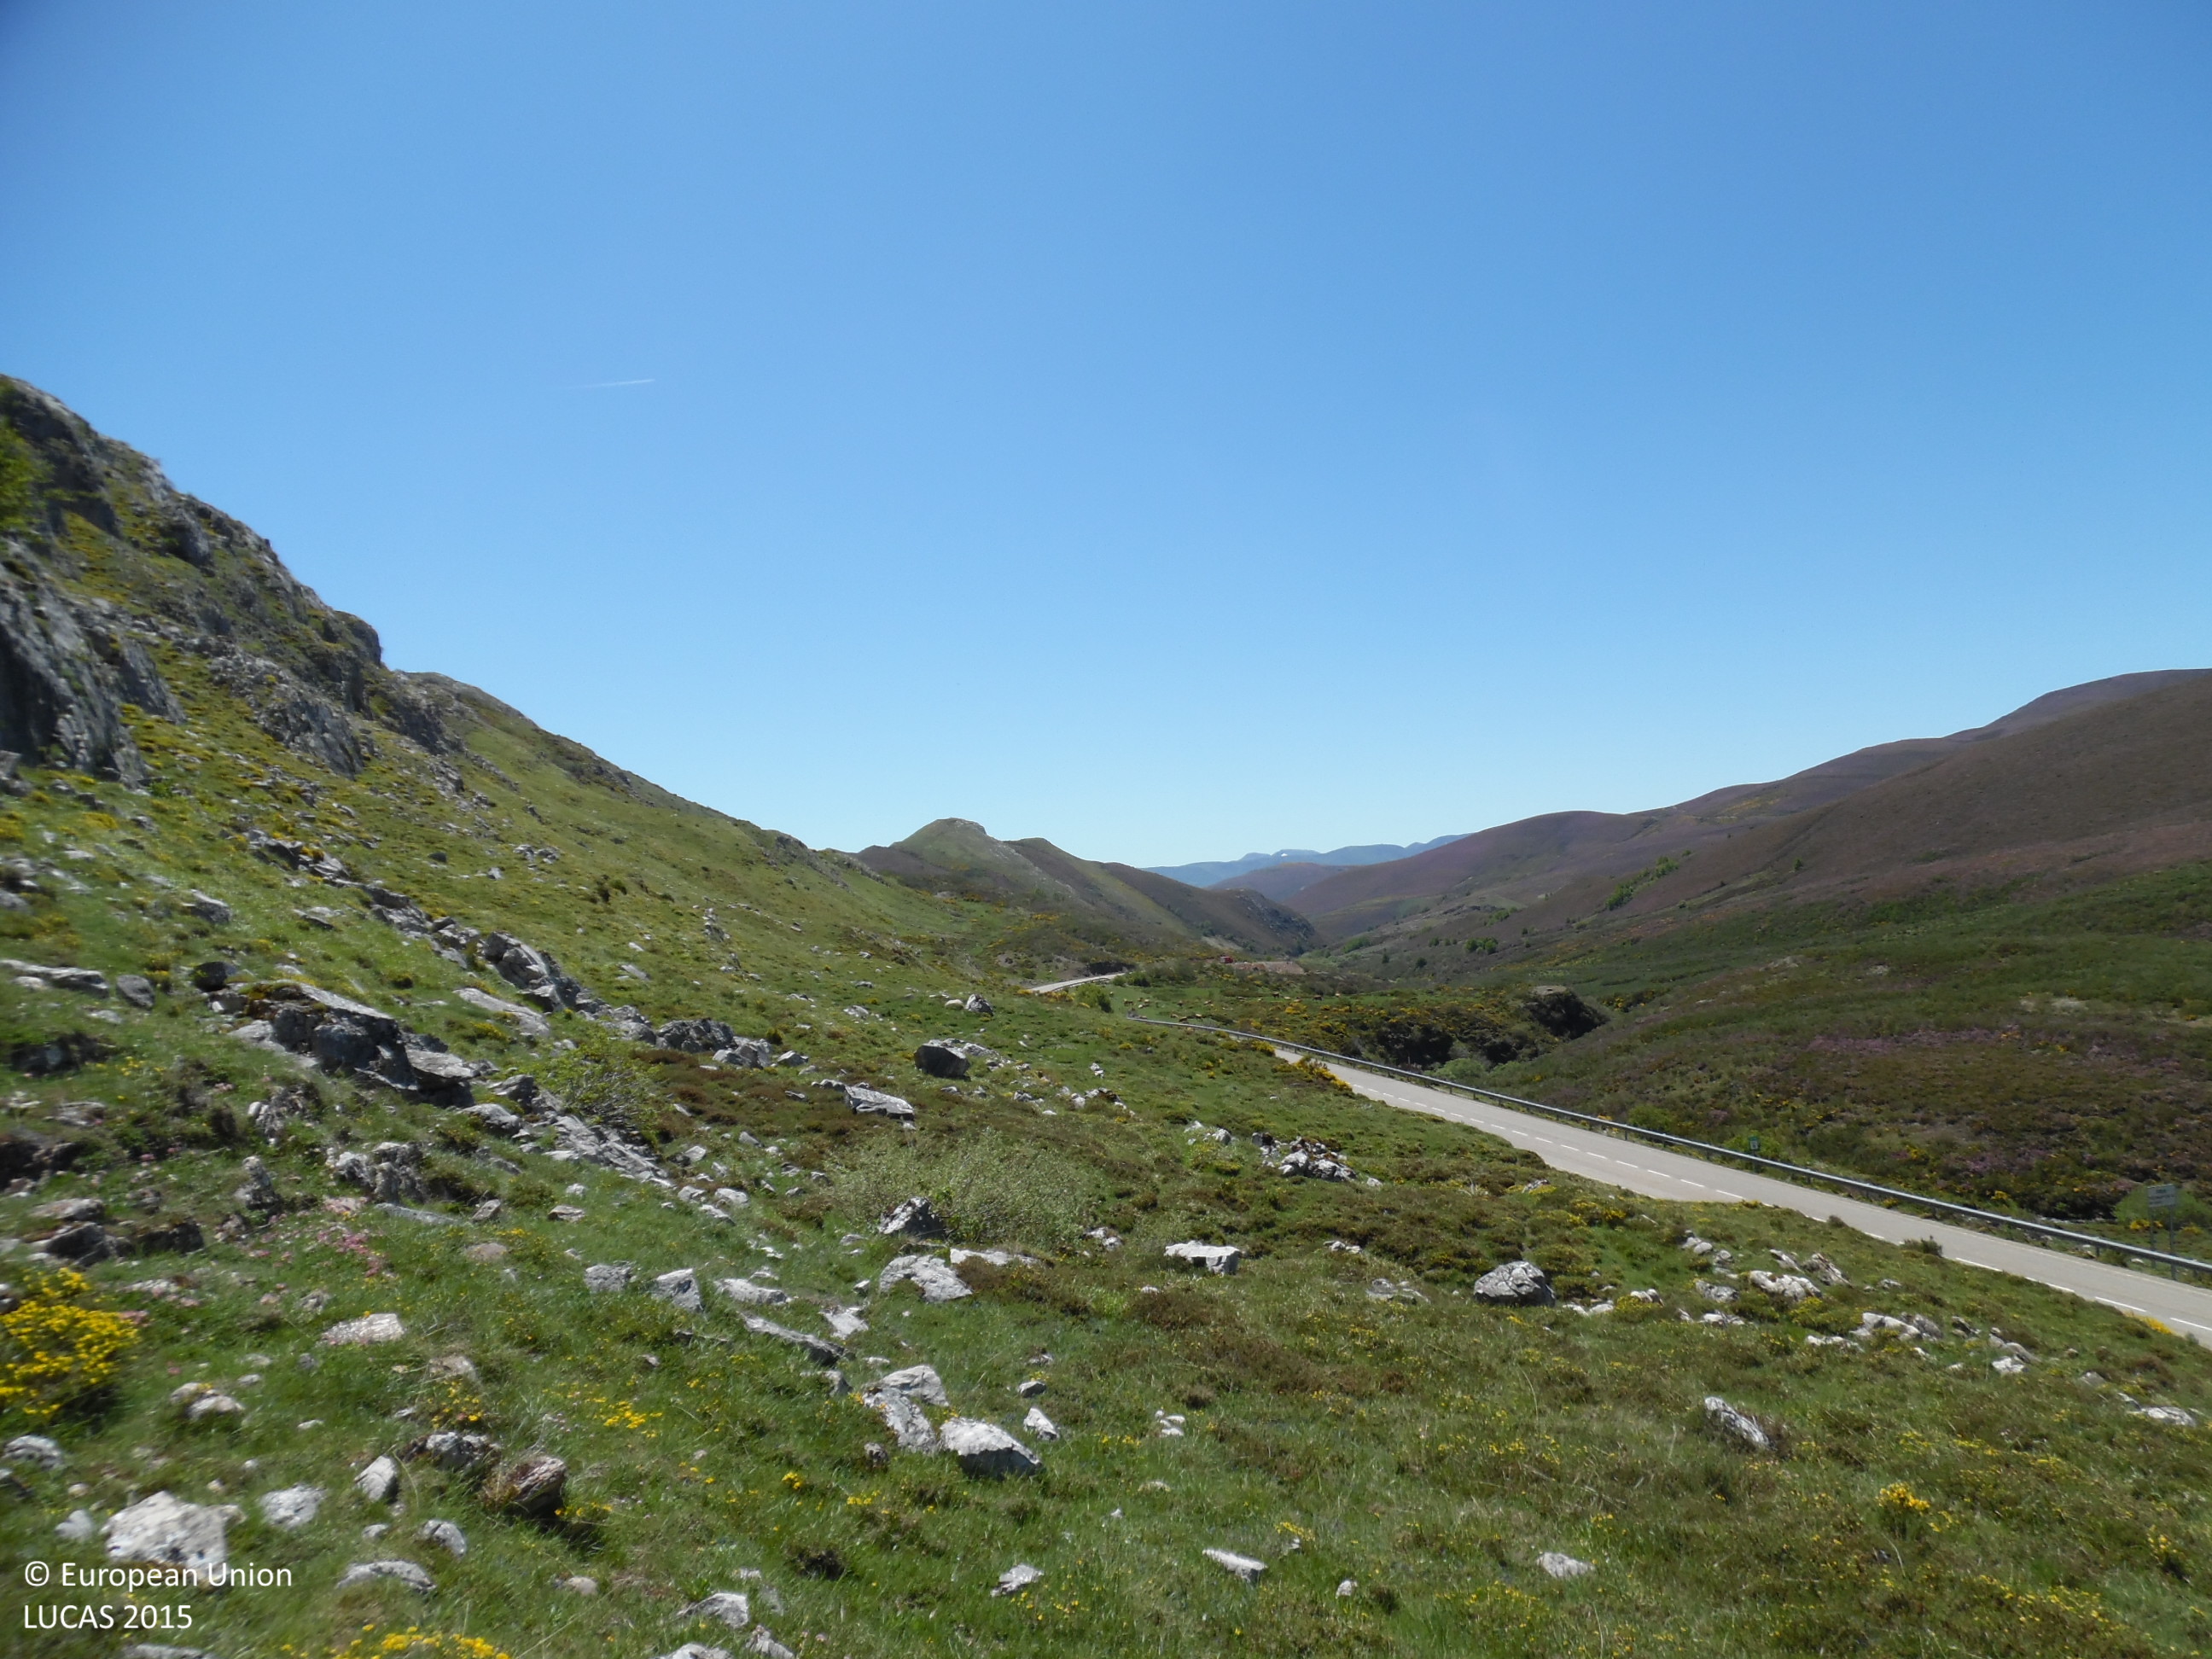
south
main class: Grassland
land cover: Grassland without tree/shrub cover
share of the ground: 50 - 75 %
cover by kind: herbaceous plants 95 %, consolidated bare surface 5 %
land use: Agriculture (excluding fallow land and kitchen gardens)
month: May
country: ES
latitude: 43.0082
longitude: -6.2251
